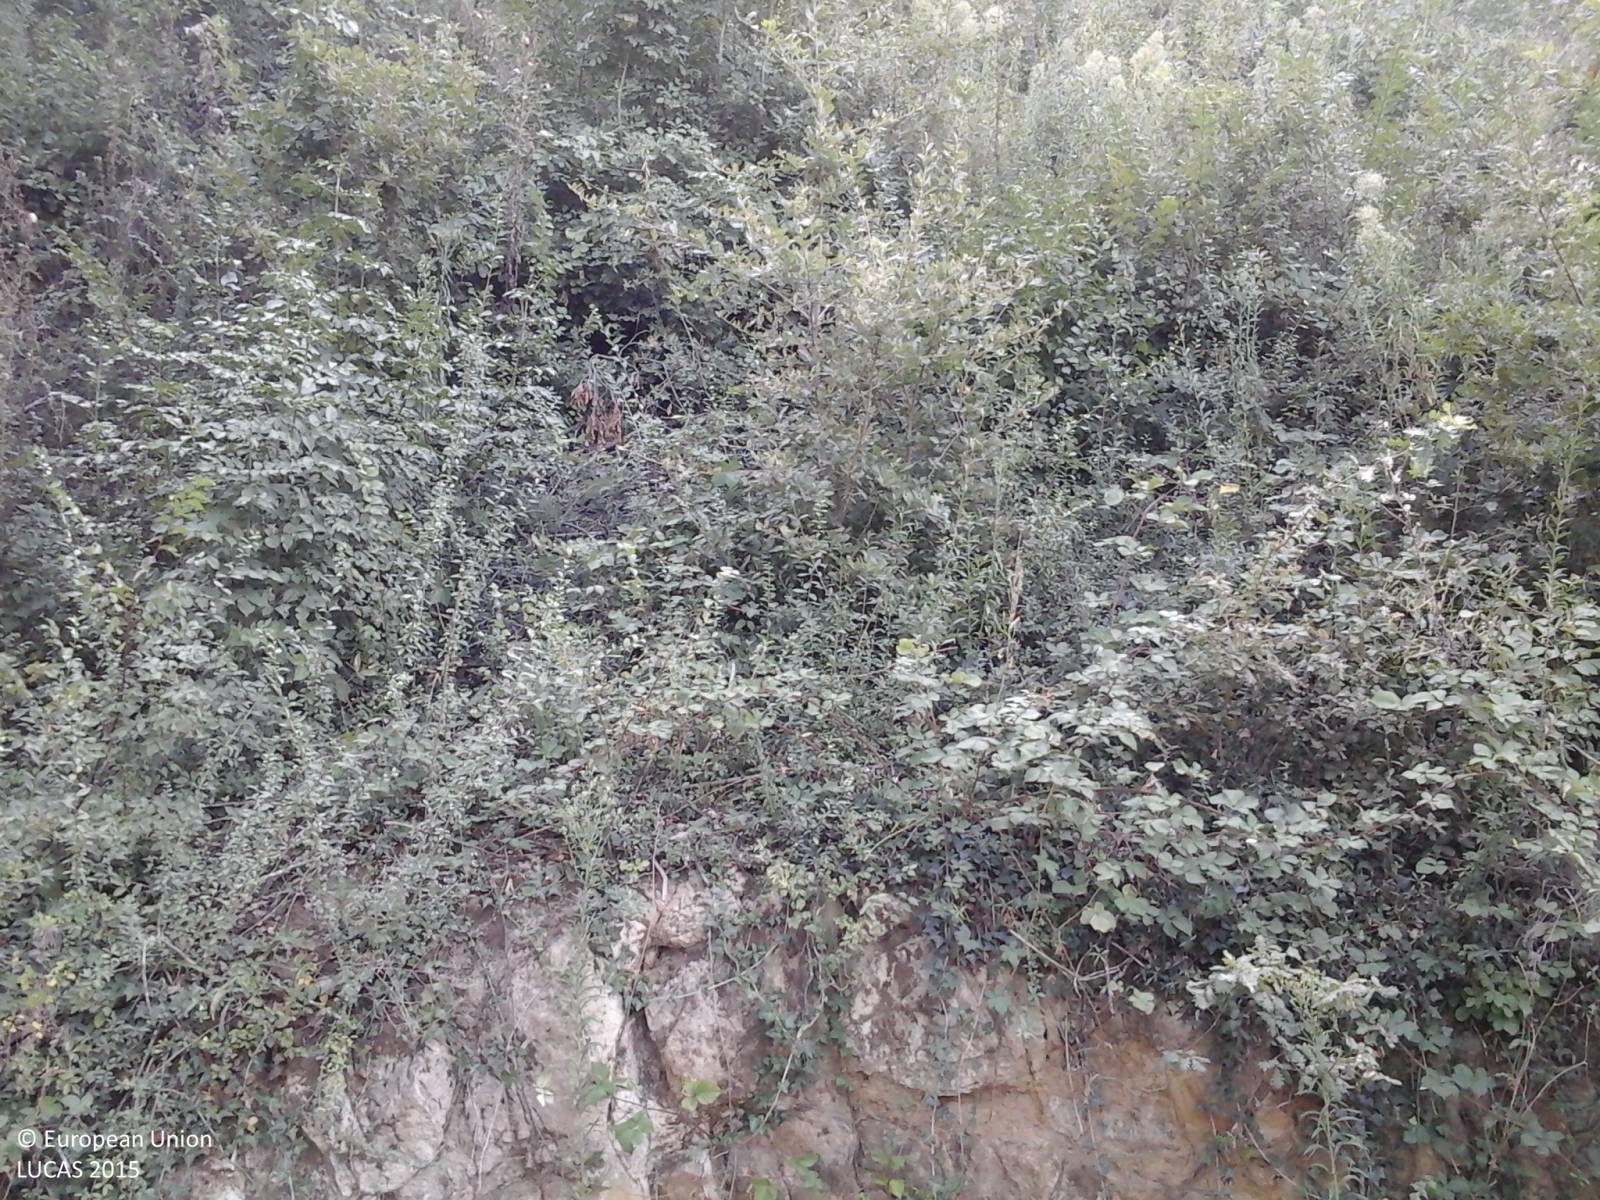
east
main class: Woodland
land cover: Broadleaved woodland
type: mesophytic deciduous forest
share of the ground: > 75 %
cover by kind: broadleaved forest trees 85 %, shrubs 15 %
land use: Forestry
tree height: > 5 m
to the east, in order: Broadleaved woodland; Artificial constructions in urban areas; Broadleaved woodland
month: September
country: IT
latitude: 43.1502
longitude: 12.3665
